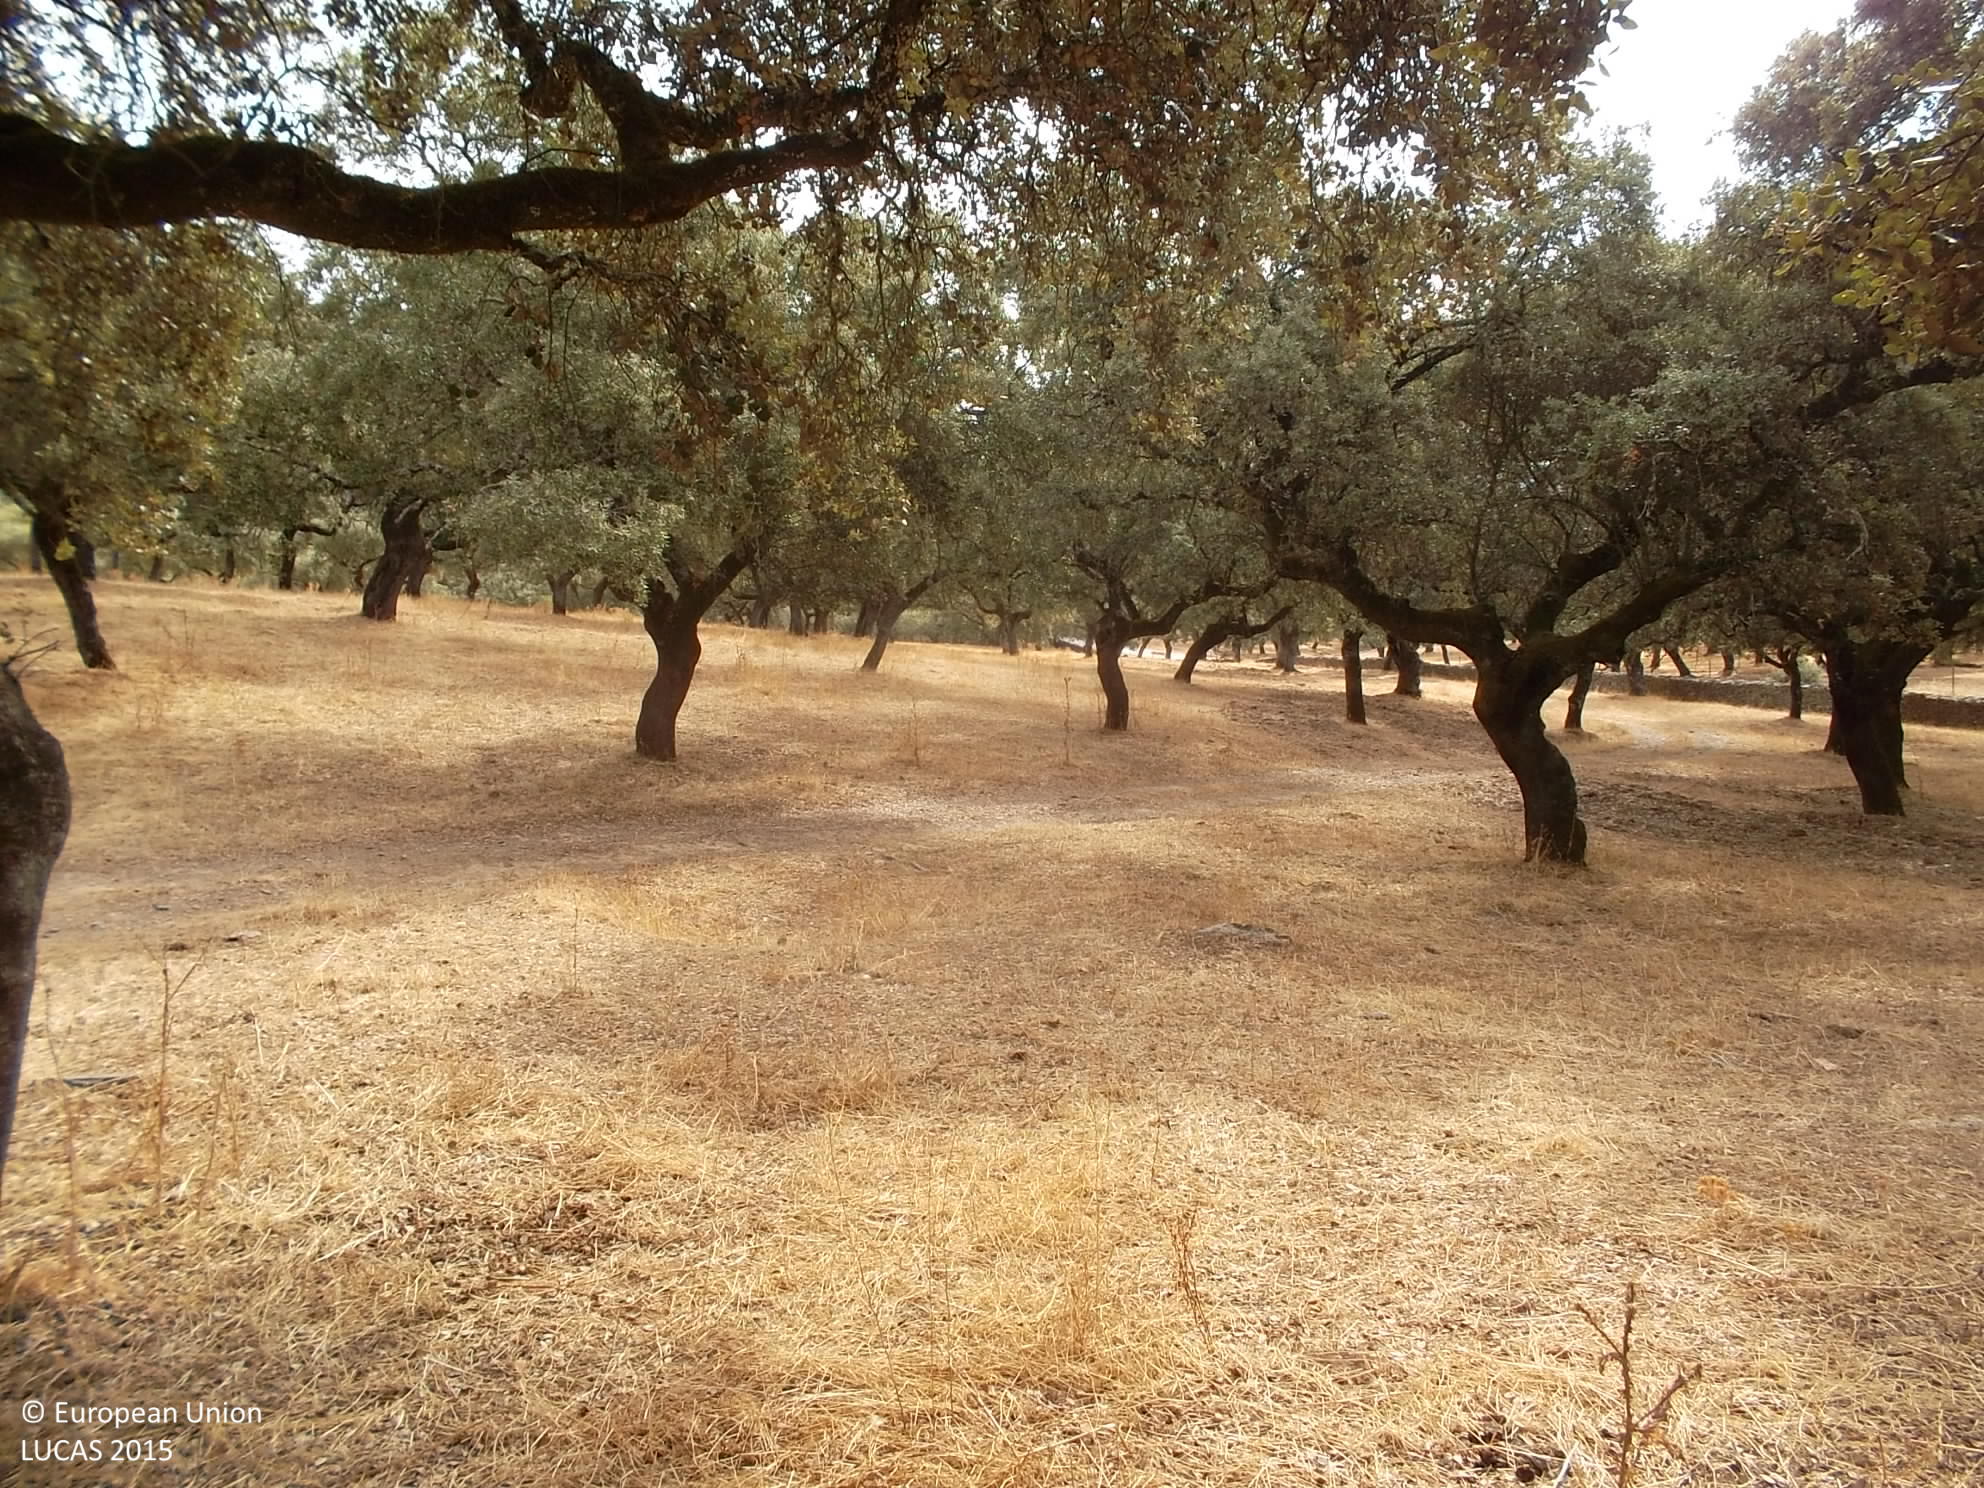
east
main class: Woodland
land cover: Broadleaved woodland
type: broadleaved evergreen forest
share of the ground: 50 - 75 %
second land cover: Grassland without tree/shrub cover
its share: > 75 %
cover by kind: broadleaved forest trees 60 %, herbaceous plants 40 %
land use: Forestry
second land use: Agriculture (excluding fallow land and kitchen gardens)
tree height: > 5 m
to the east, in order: Broadleaved woodland; Grassland without tree/shrub cover; Tracks; Broadleaved woodland; Dry stone walls; Grass margins; Paved roads, cycling and walking lanes; Grass margins; Fences; Broadleaved woodland
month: September
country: ES
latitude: 38.0856
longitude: -6.4977
